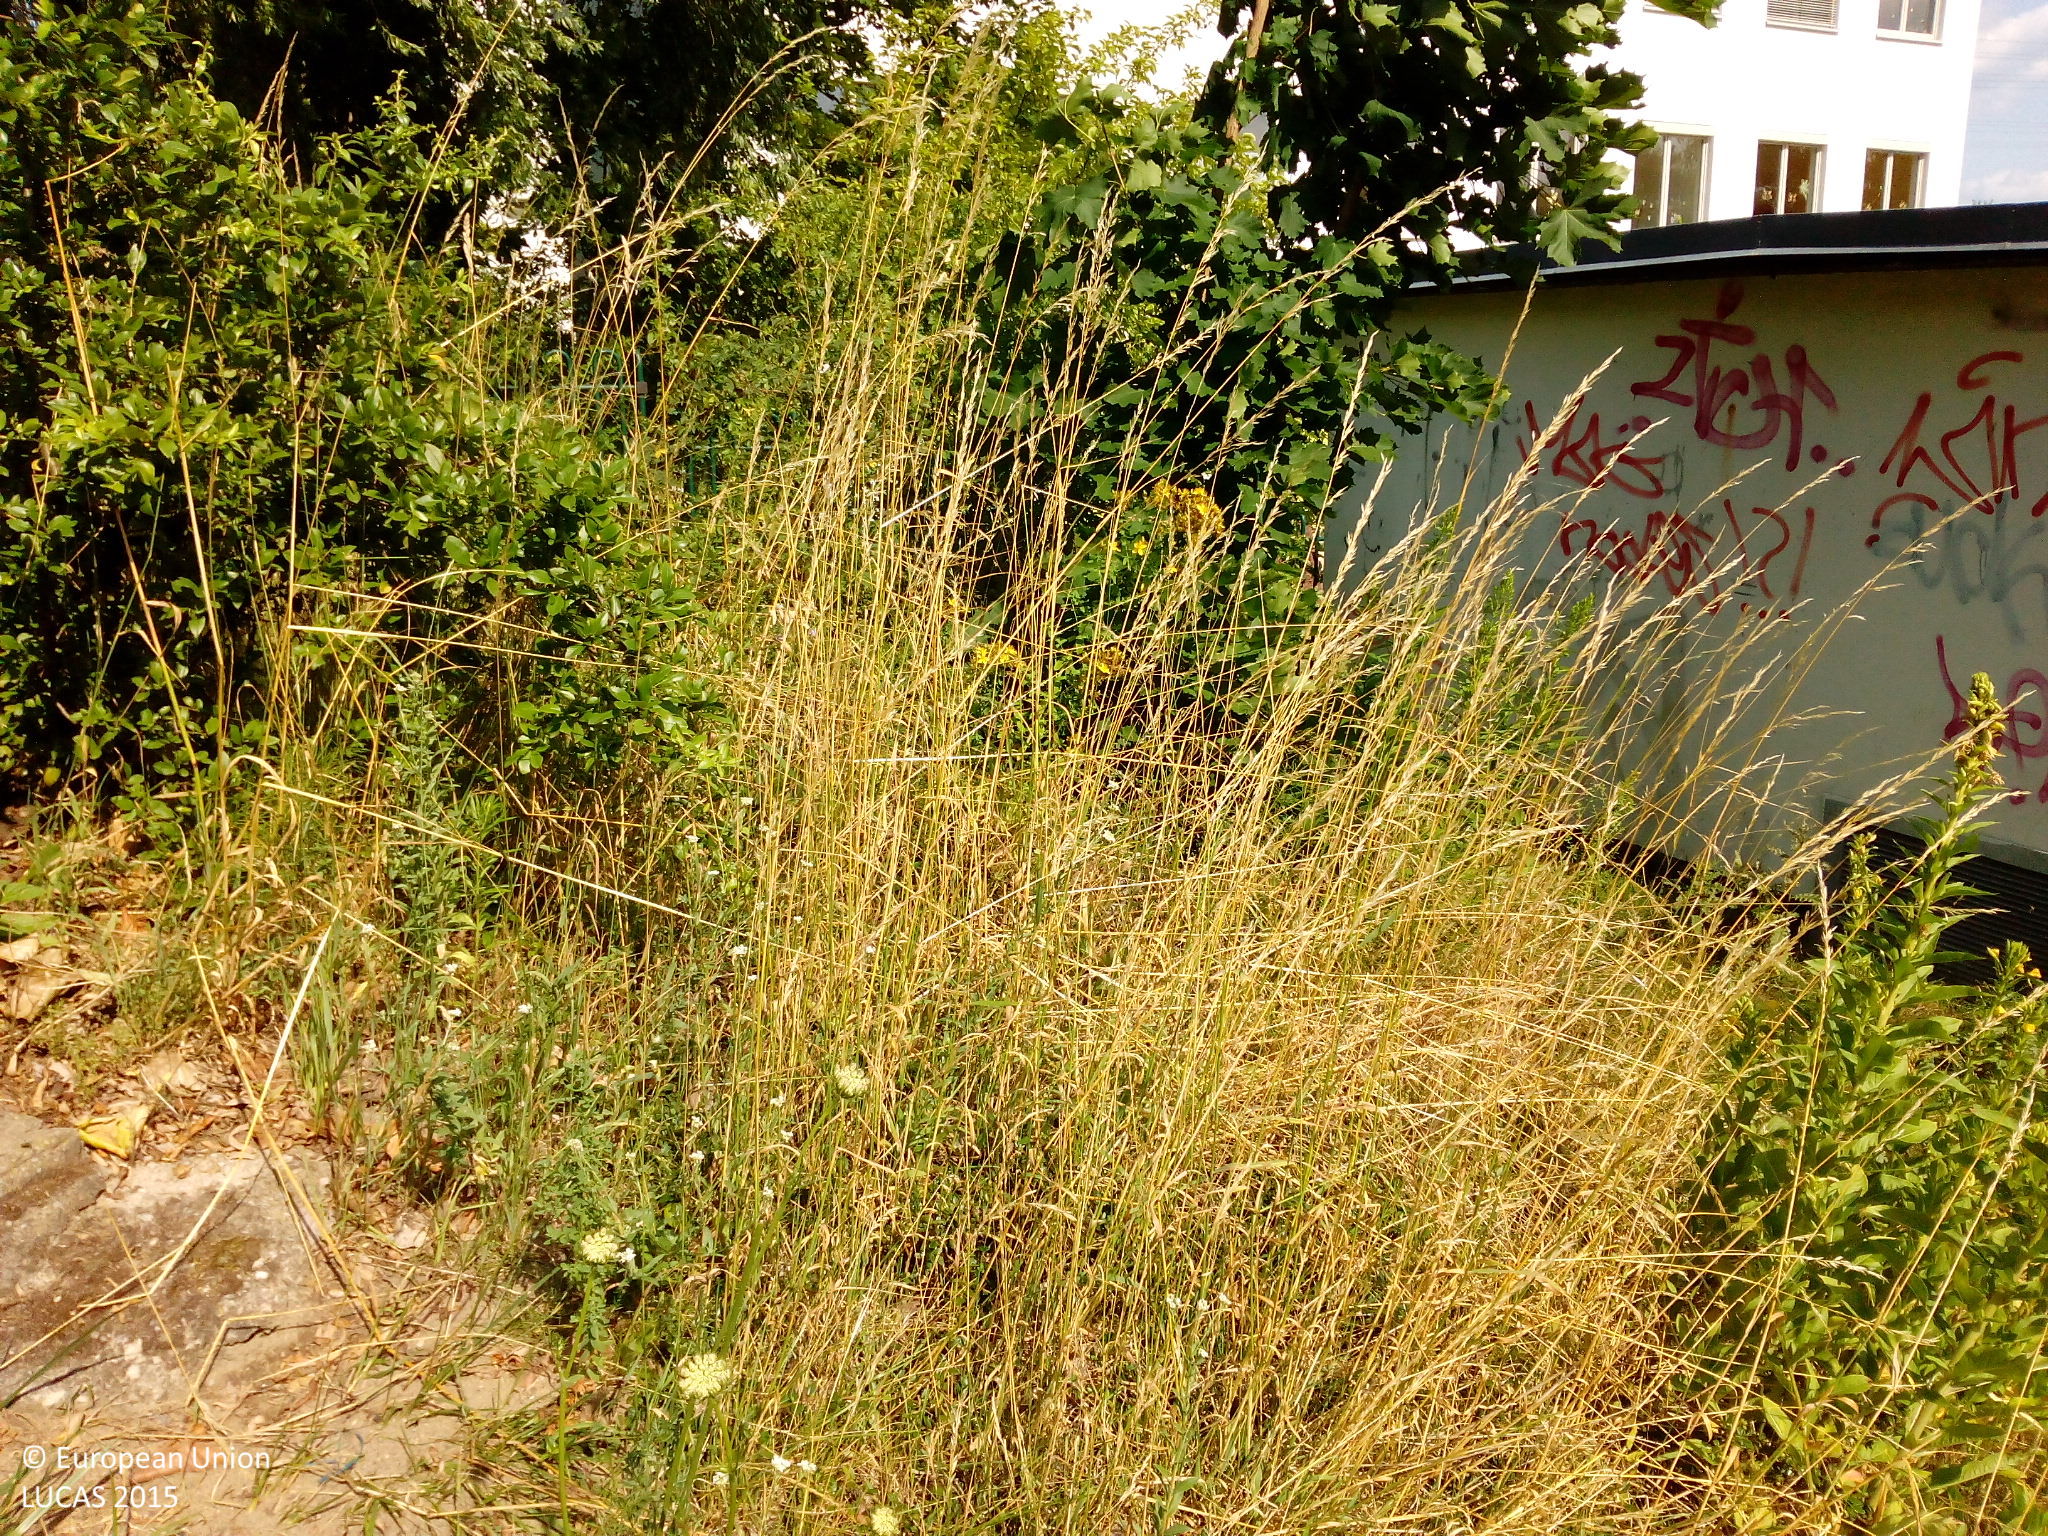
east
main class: Grassland
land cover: Grassland without tree/shrub cover
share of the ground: > 75 %
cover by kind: consolidated bare surface 75 %, herbaceous plants 25 %
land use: Semi-natural and natural areas not in use
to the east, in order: Grassland without tree/shrub cover; Artificial constructions in urban areas; Broadleaved woodland
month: July
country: DE
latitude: 52.5385
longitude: 13.6125
